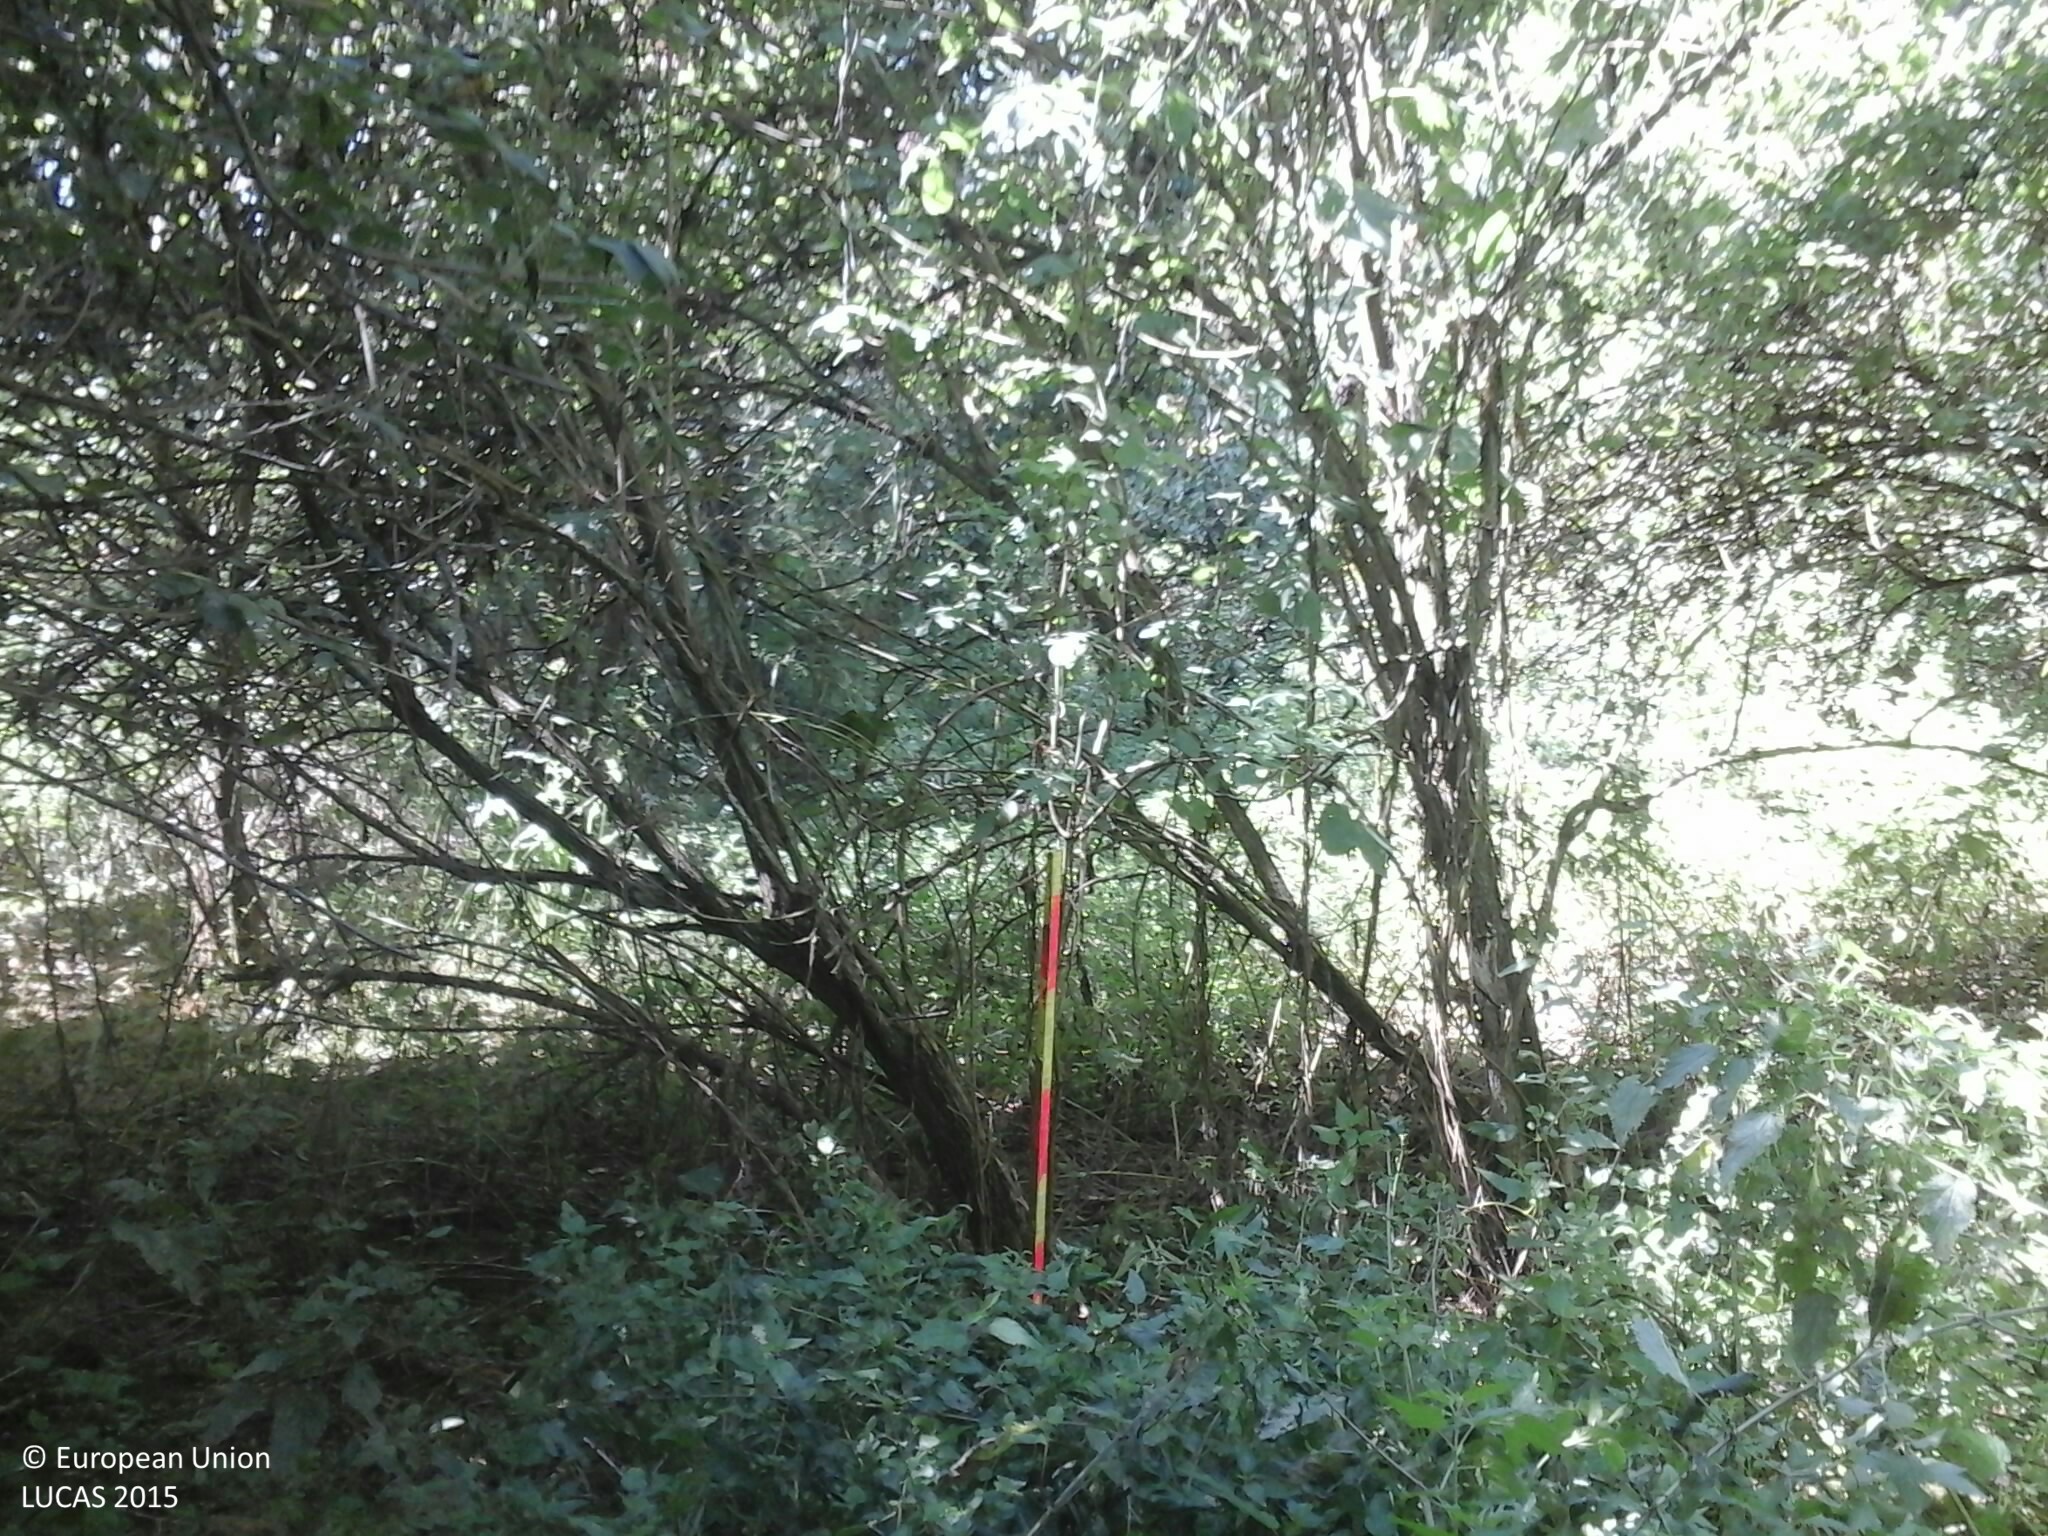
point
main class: Woodland
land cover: Broadleaved woodland
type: mesophytic deciduous forest
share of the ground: > 75 %
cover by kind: broadleaved forest trees 90 %, herbaceous plants 10 %
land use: Forestry
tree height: > 5 m
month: August
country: HU
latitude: 46.5927
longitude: 17.7728
